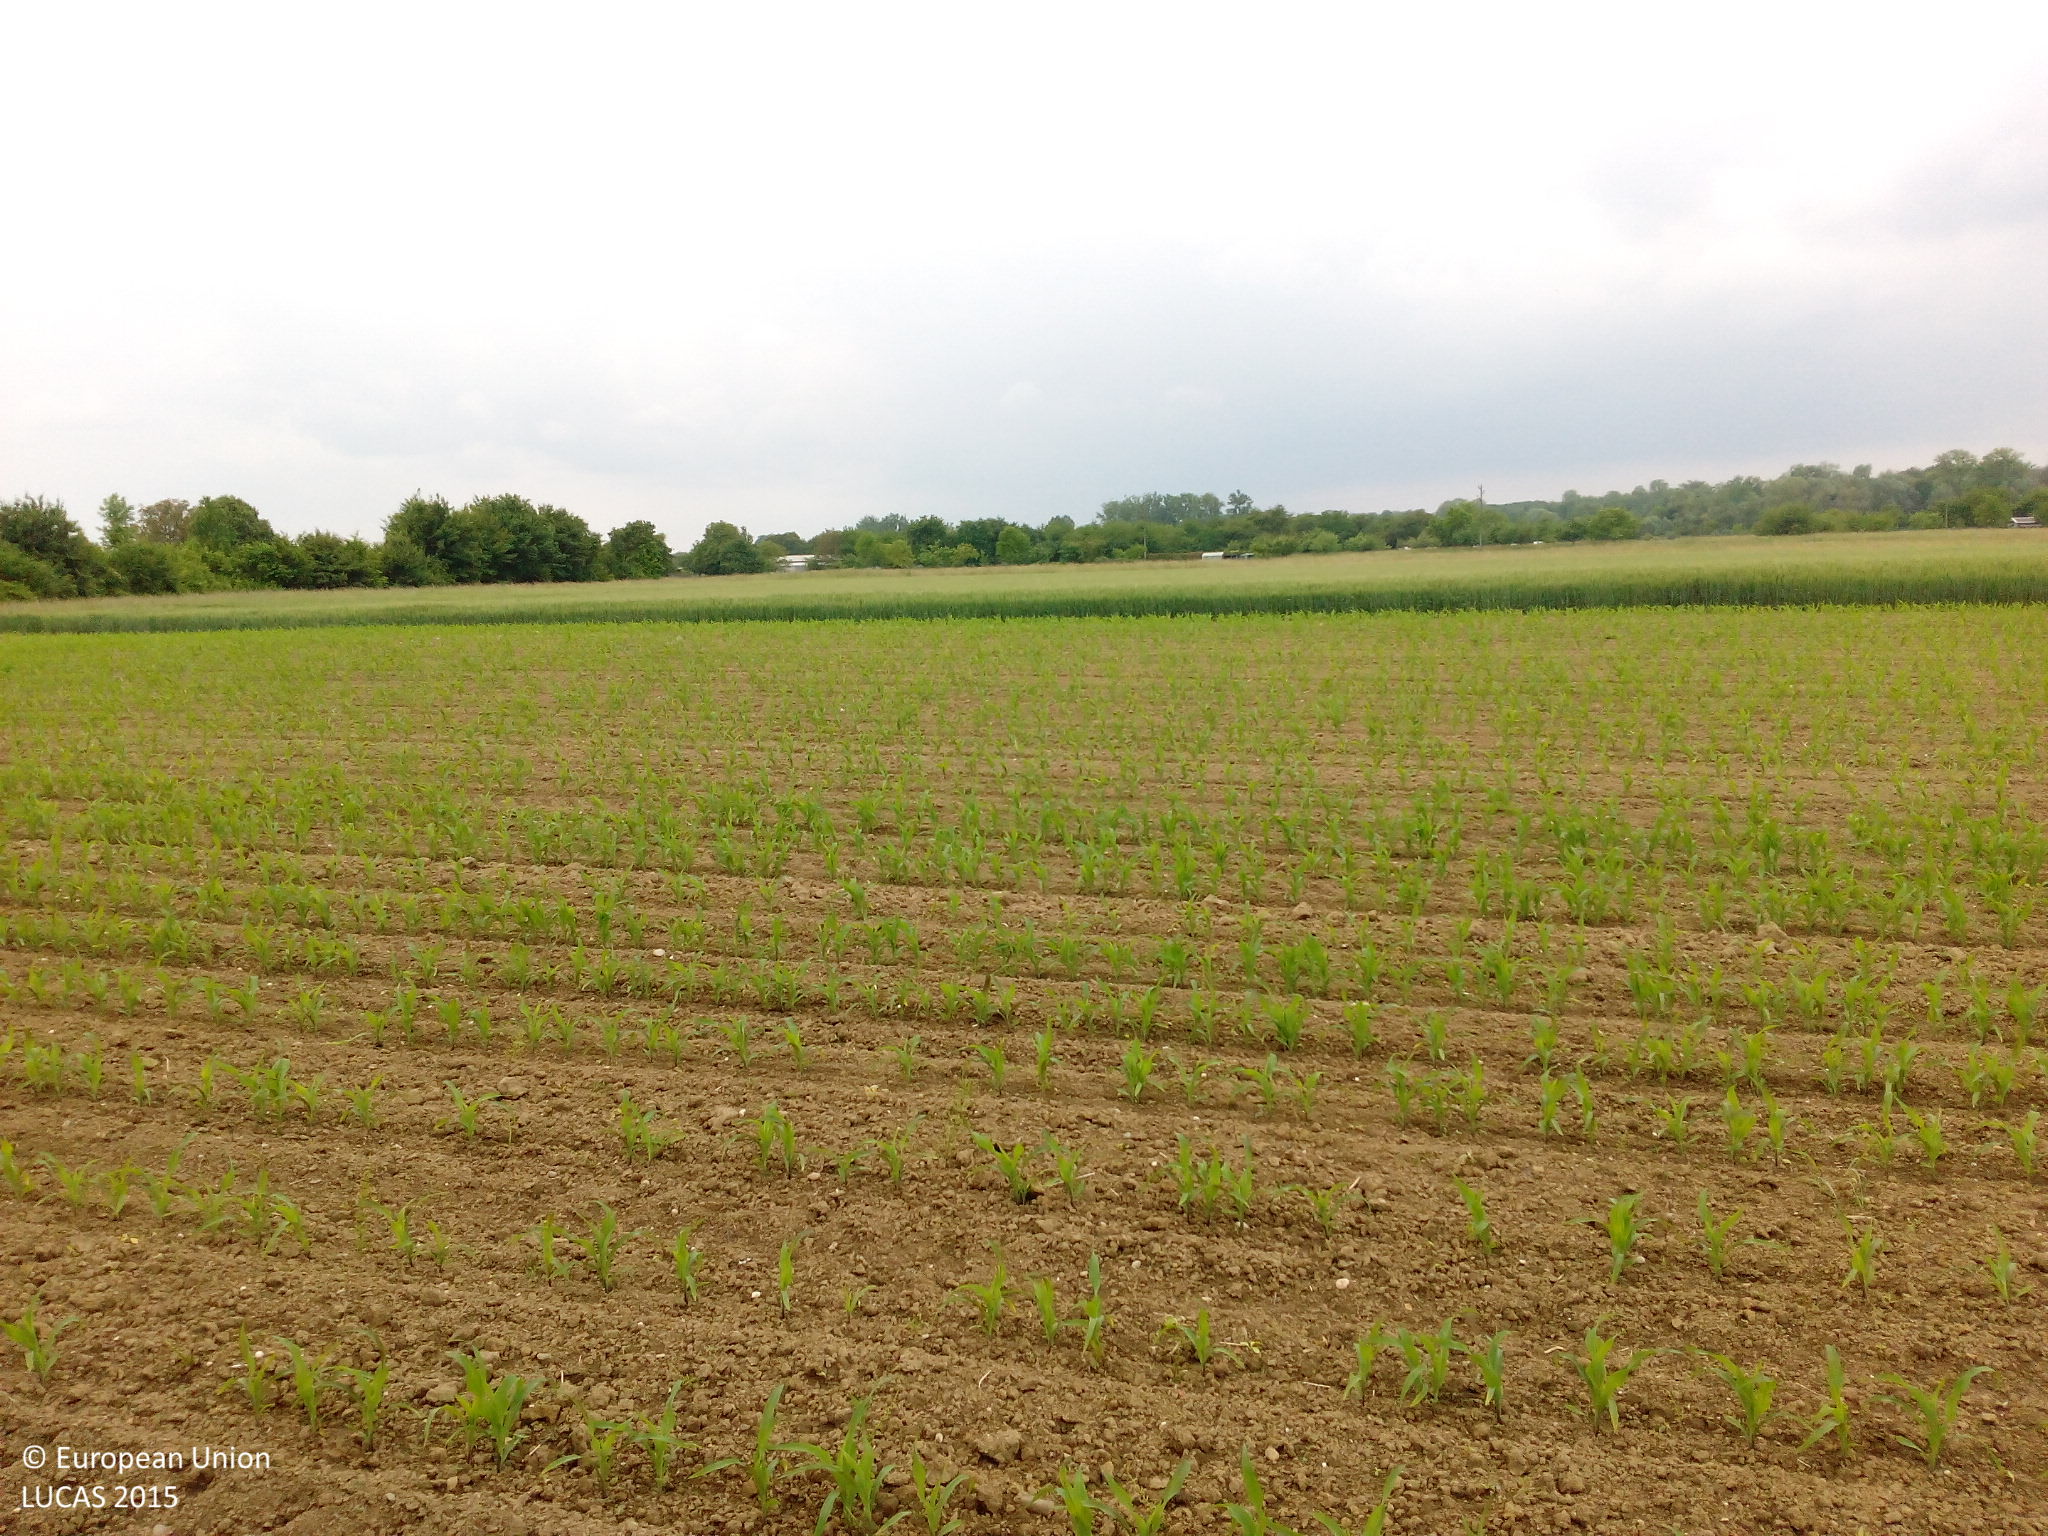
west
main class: Cropland
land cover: Maize
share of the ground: < 10 %
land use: Agriculture (excluding fallow land and kitchen gardens)
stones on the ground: < 10 %
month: May
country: DE
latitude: 48.8741
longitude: 8.1600
